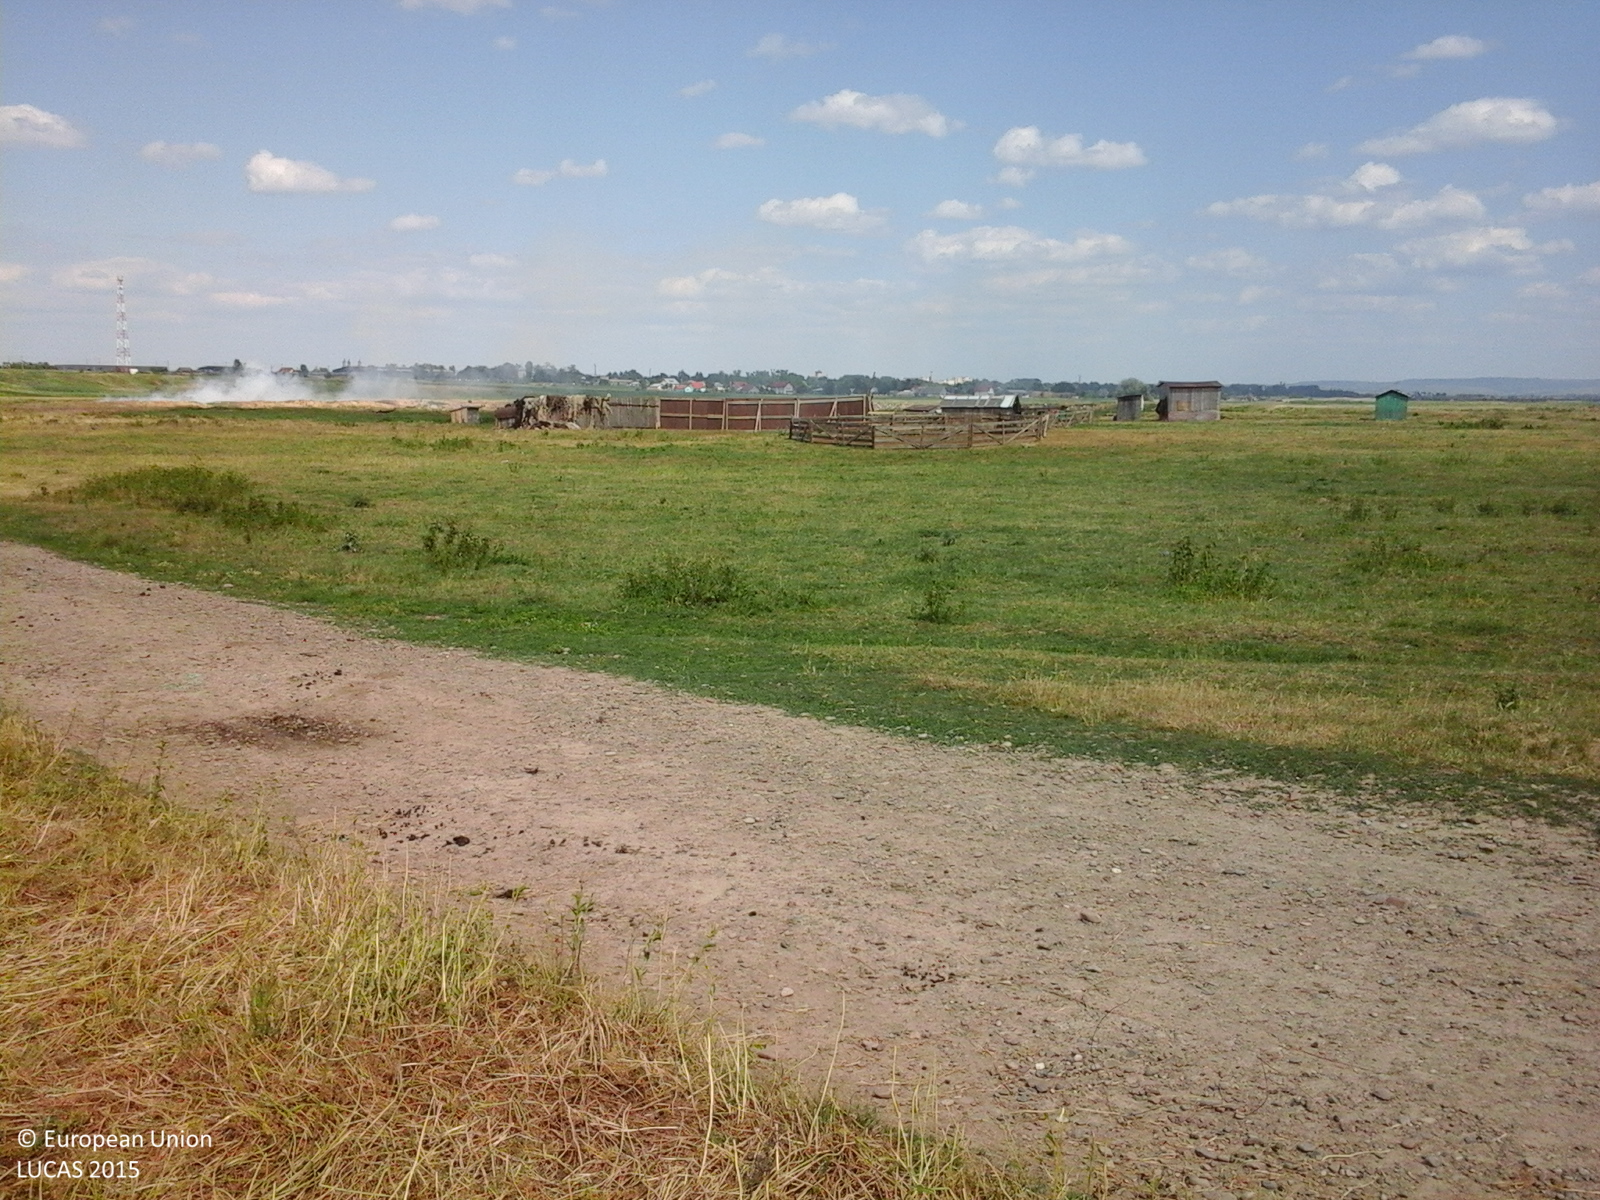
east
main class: Grassland
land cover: Spontaneously vegetated surfaces
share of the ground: > 75 %
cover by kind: herbaceous plants 100 %
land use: Agriculture (excluding fallow land and kitchen gardens)
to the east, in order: Spontaneously vegetated surfaces; Tracks; Spontaneously vegetated surfaces; Tracks; Spontaneously vegetated surfaces; Fences; Other bare soil; Fences; Spontaneously vegetated surfaces
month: June
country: RO
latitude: 47.6071
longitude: 26.4089
